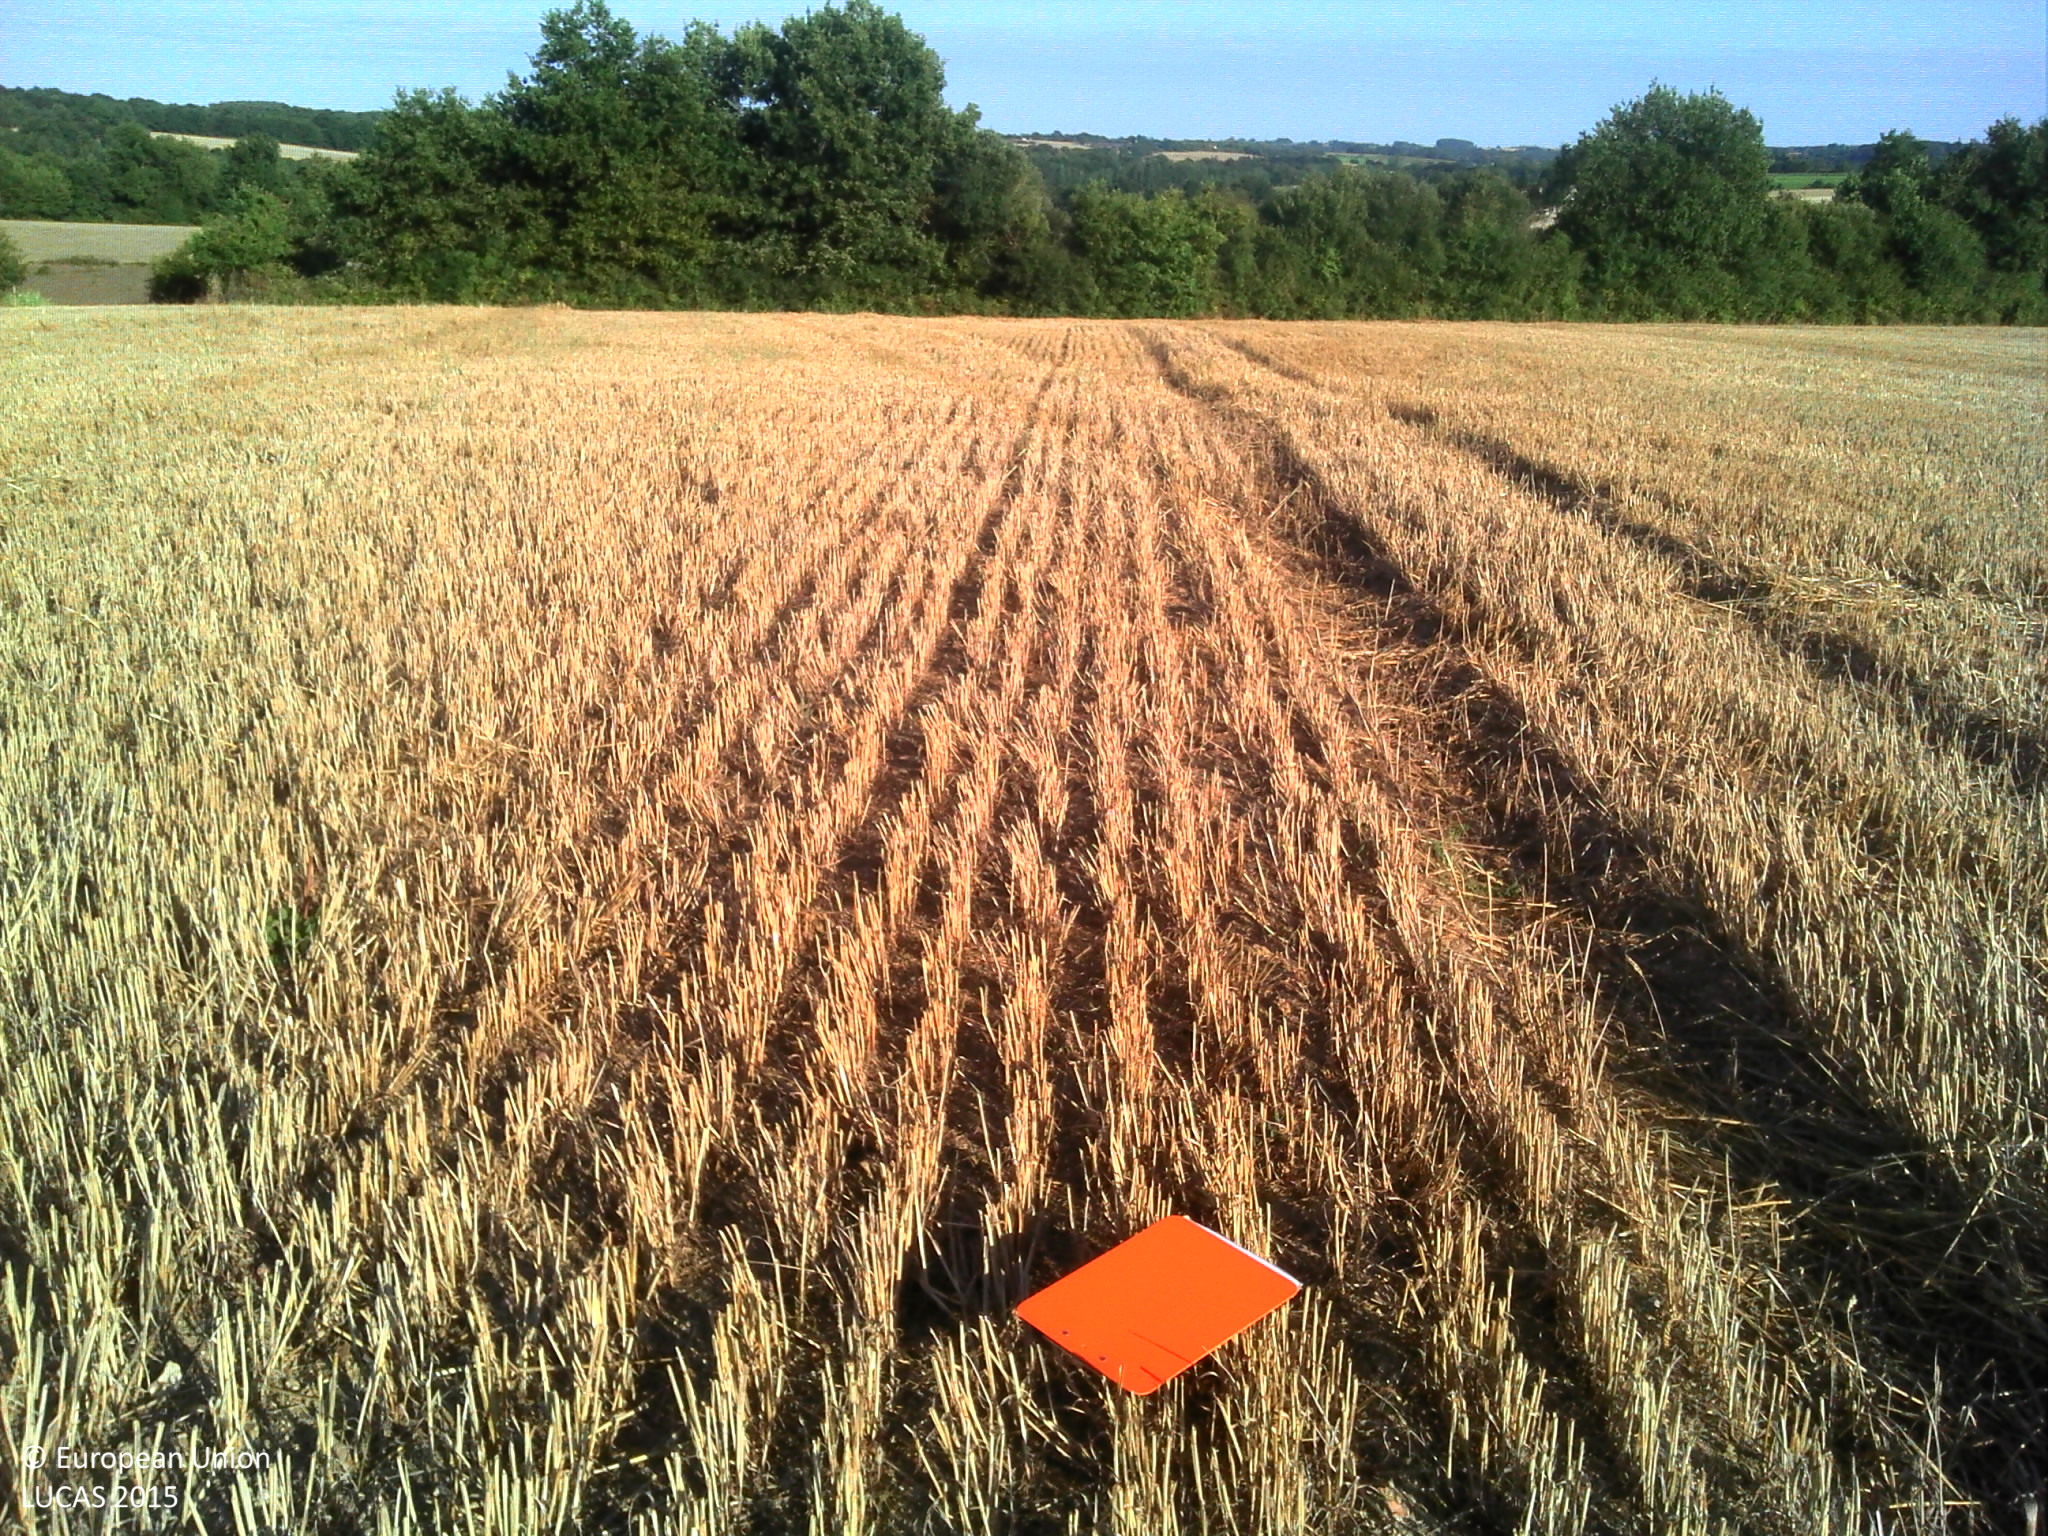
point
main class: Cropland
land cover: Common wheat
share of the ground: > 75 %
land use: Agriculture (excluding fallow land and kitchen gardens)
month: August
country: FR
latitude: 46.6439
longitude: -1.0995
